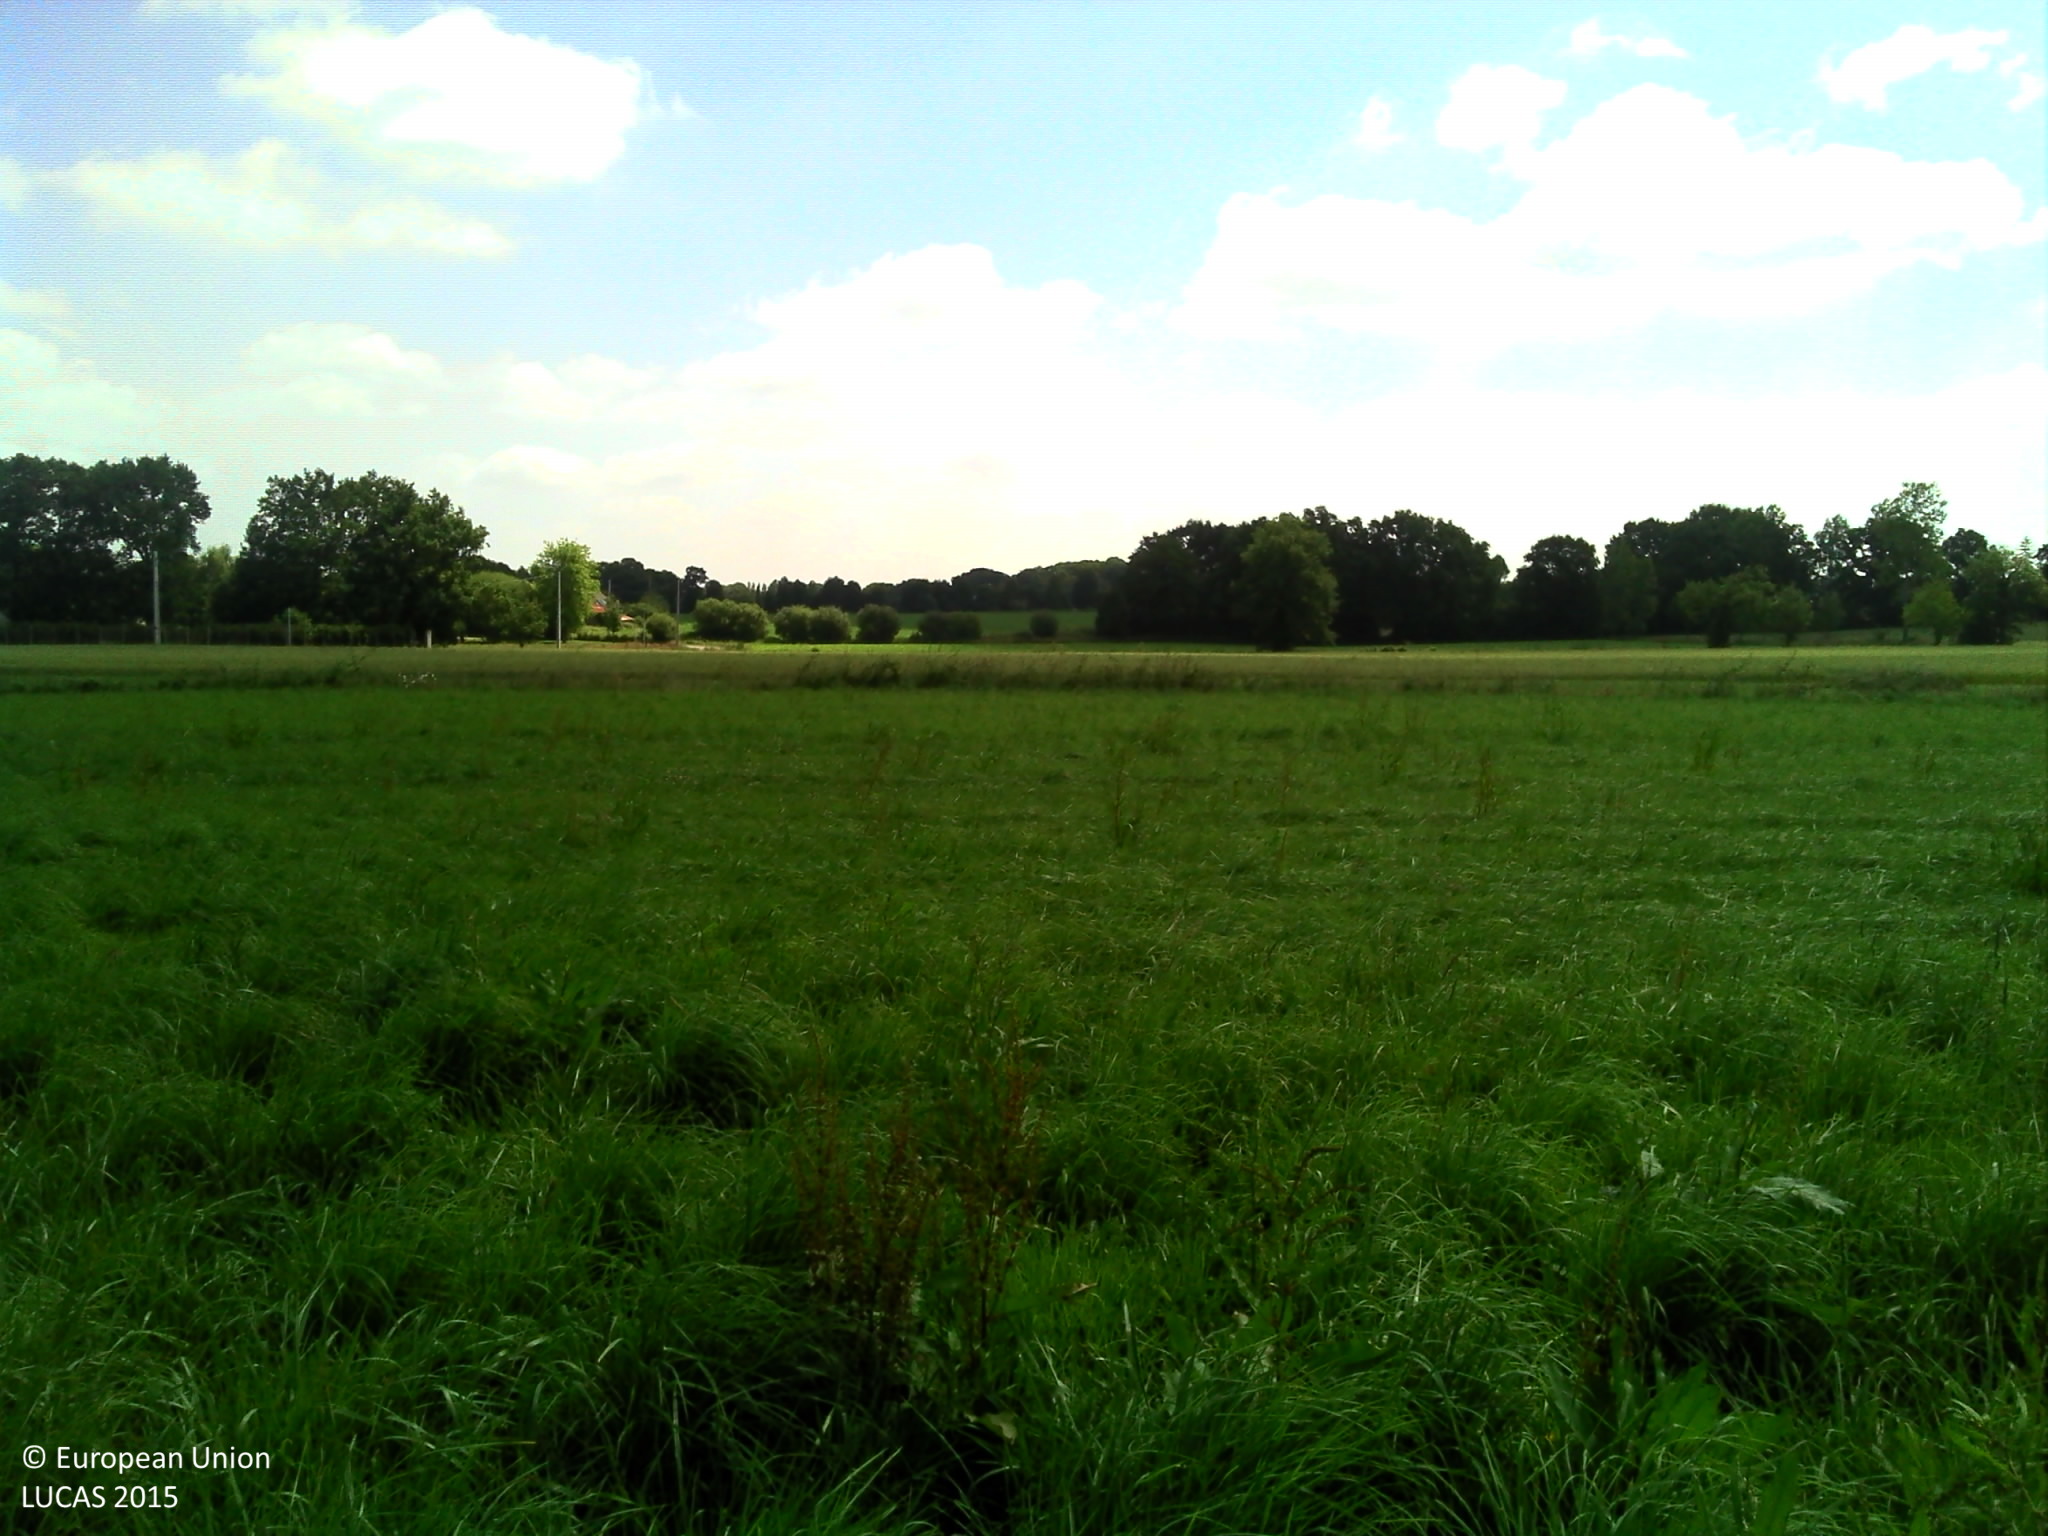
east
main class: Grassland
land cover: Grassland without tree/shrub cover
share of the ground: > 75 %
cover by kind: herbaceous plants 100 %
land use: Agriculture (excluding fallow land and kitchen gardens)
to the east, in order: Grassland without tree/shrub cover; Abandoned hedges; Grassland without tree/shrub cover; Common wheat; Grass margins; Ditches and canals; Grass margins; Maize
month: June
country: FR
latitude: 48.0318
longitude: -1.8924
